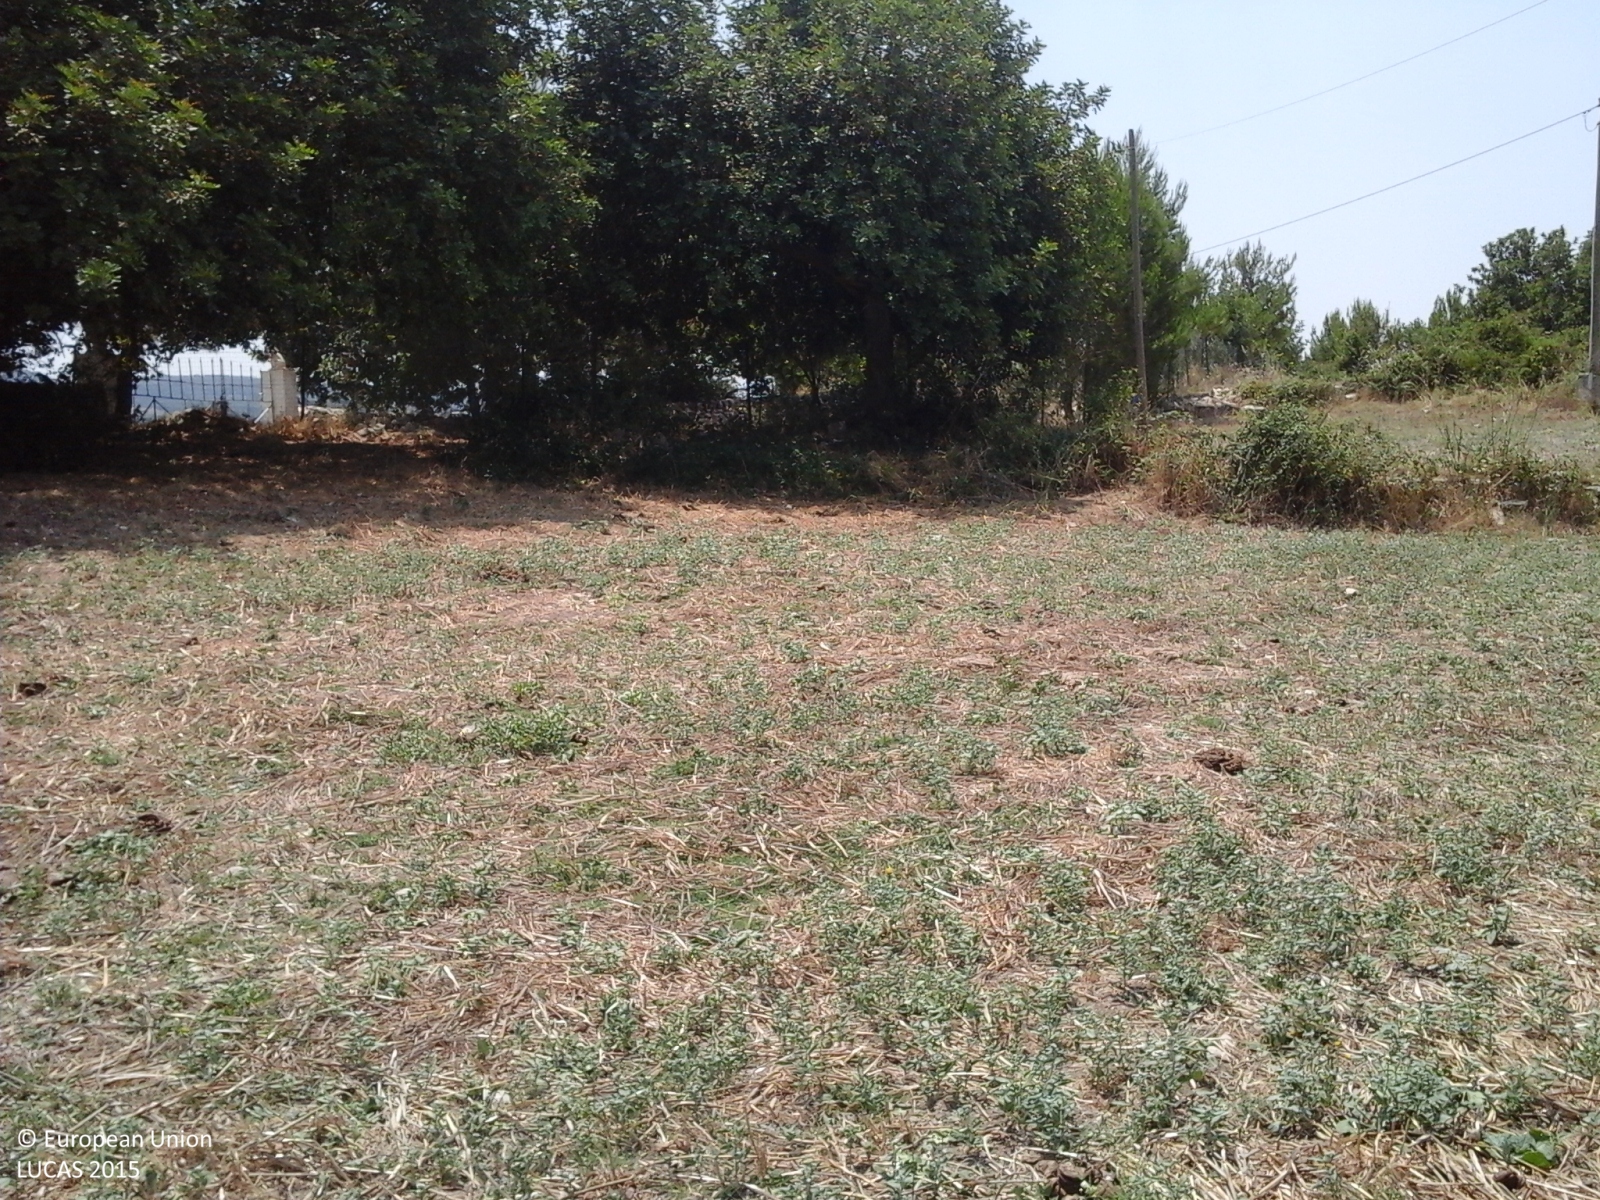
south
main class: Cropland
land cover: Mixed cereals for fodder
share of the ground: > 75 %
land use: Agriculture (excluding fallow land and kitchen gardens)
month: July
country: IT
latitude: 36.9736
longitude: 14.7591
